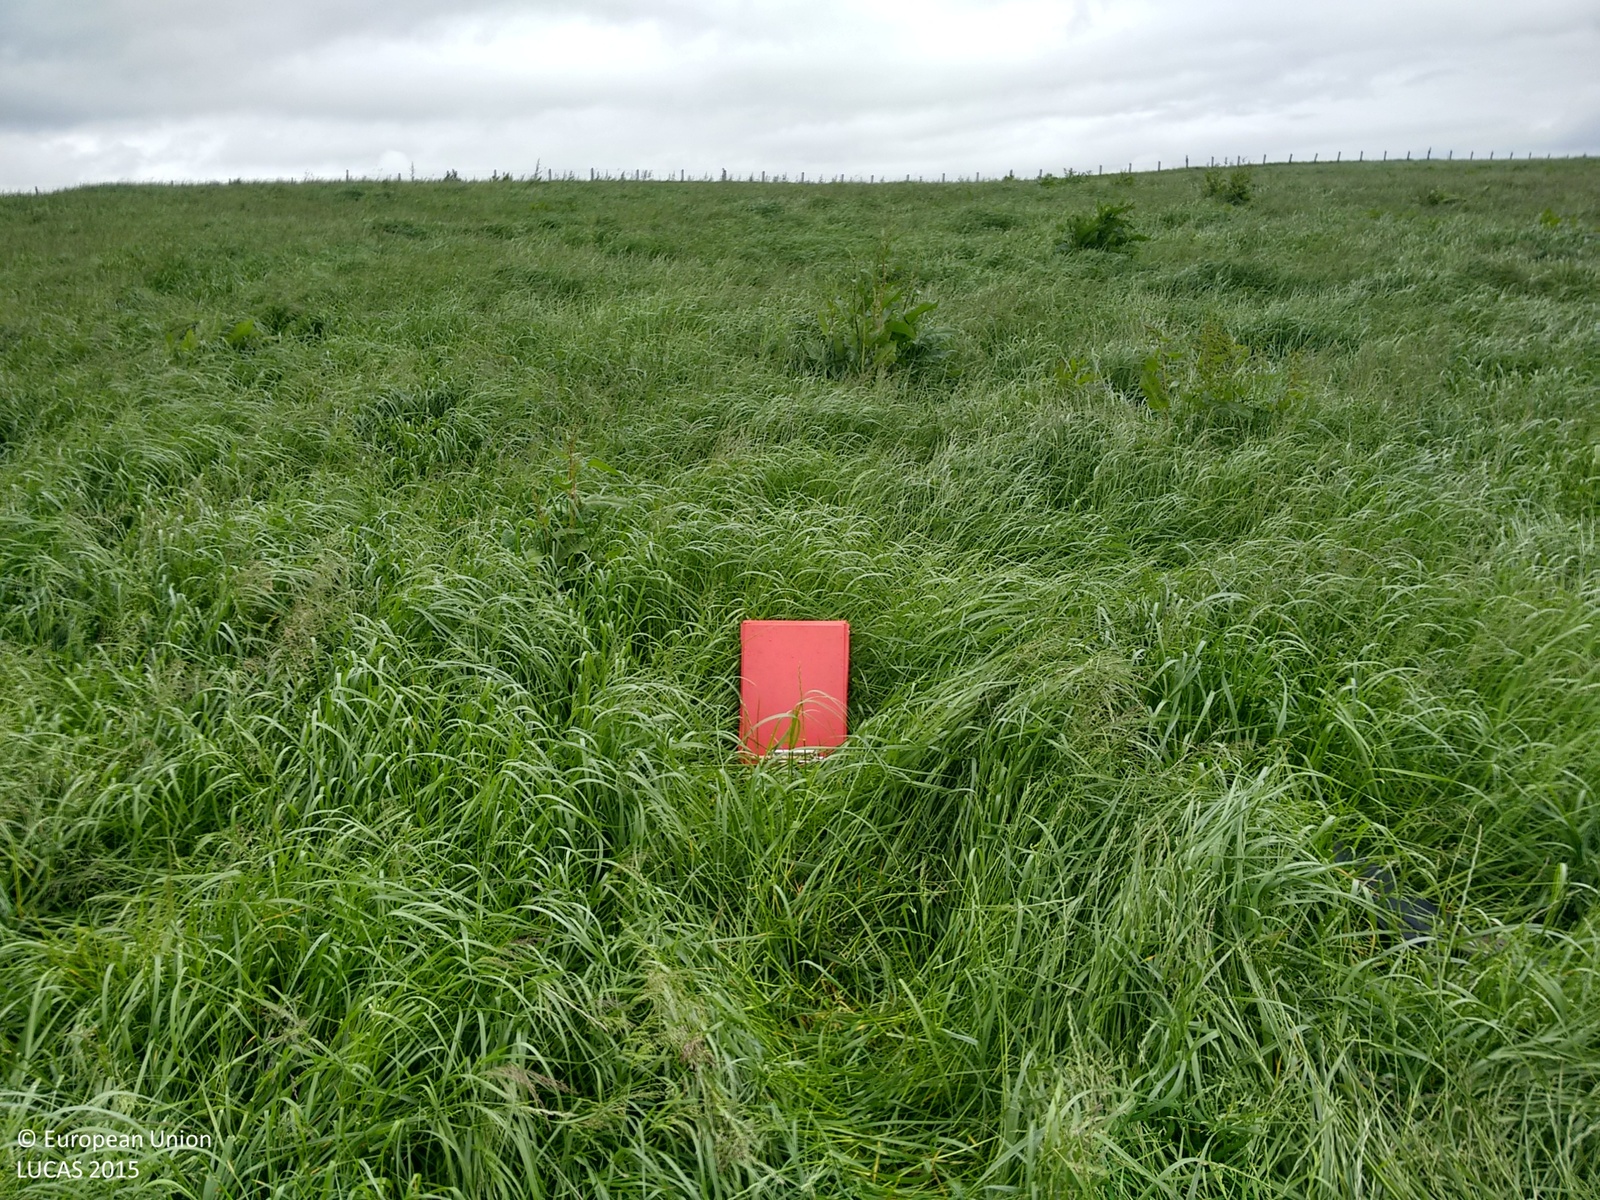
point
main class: Grassland
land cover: Grassland without tree/shrub cover
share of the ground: > 75 %
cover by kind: herbaceous plants 100 %
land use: Agriculture (excluding fallow land and kitchen gardens)
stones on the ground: < 10 %
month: June
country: GB
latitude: 55.7160
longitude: -3.7570
